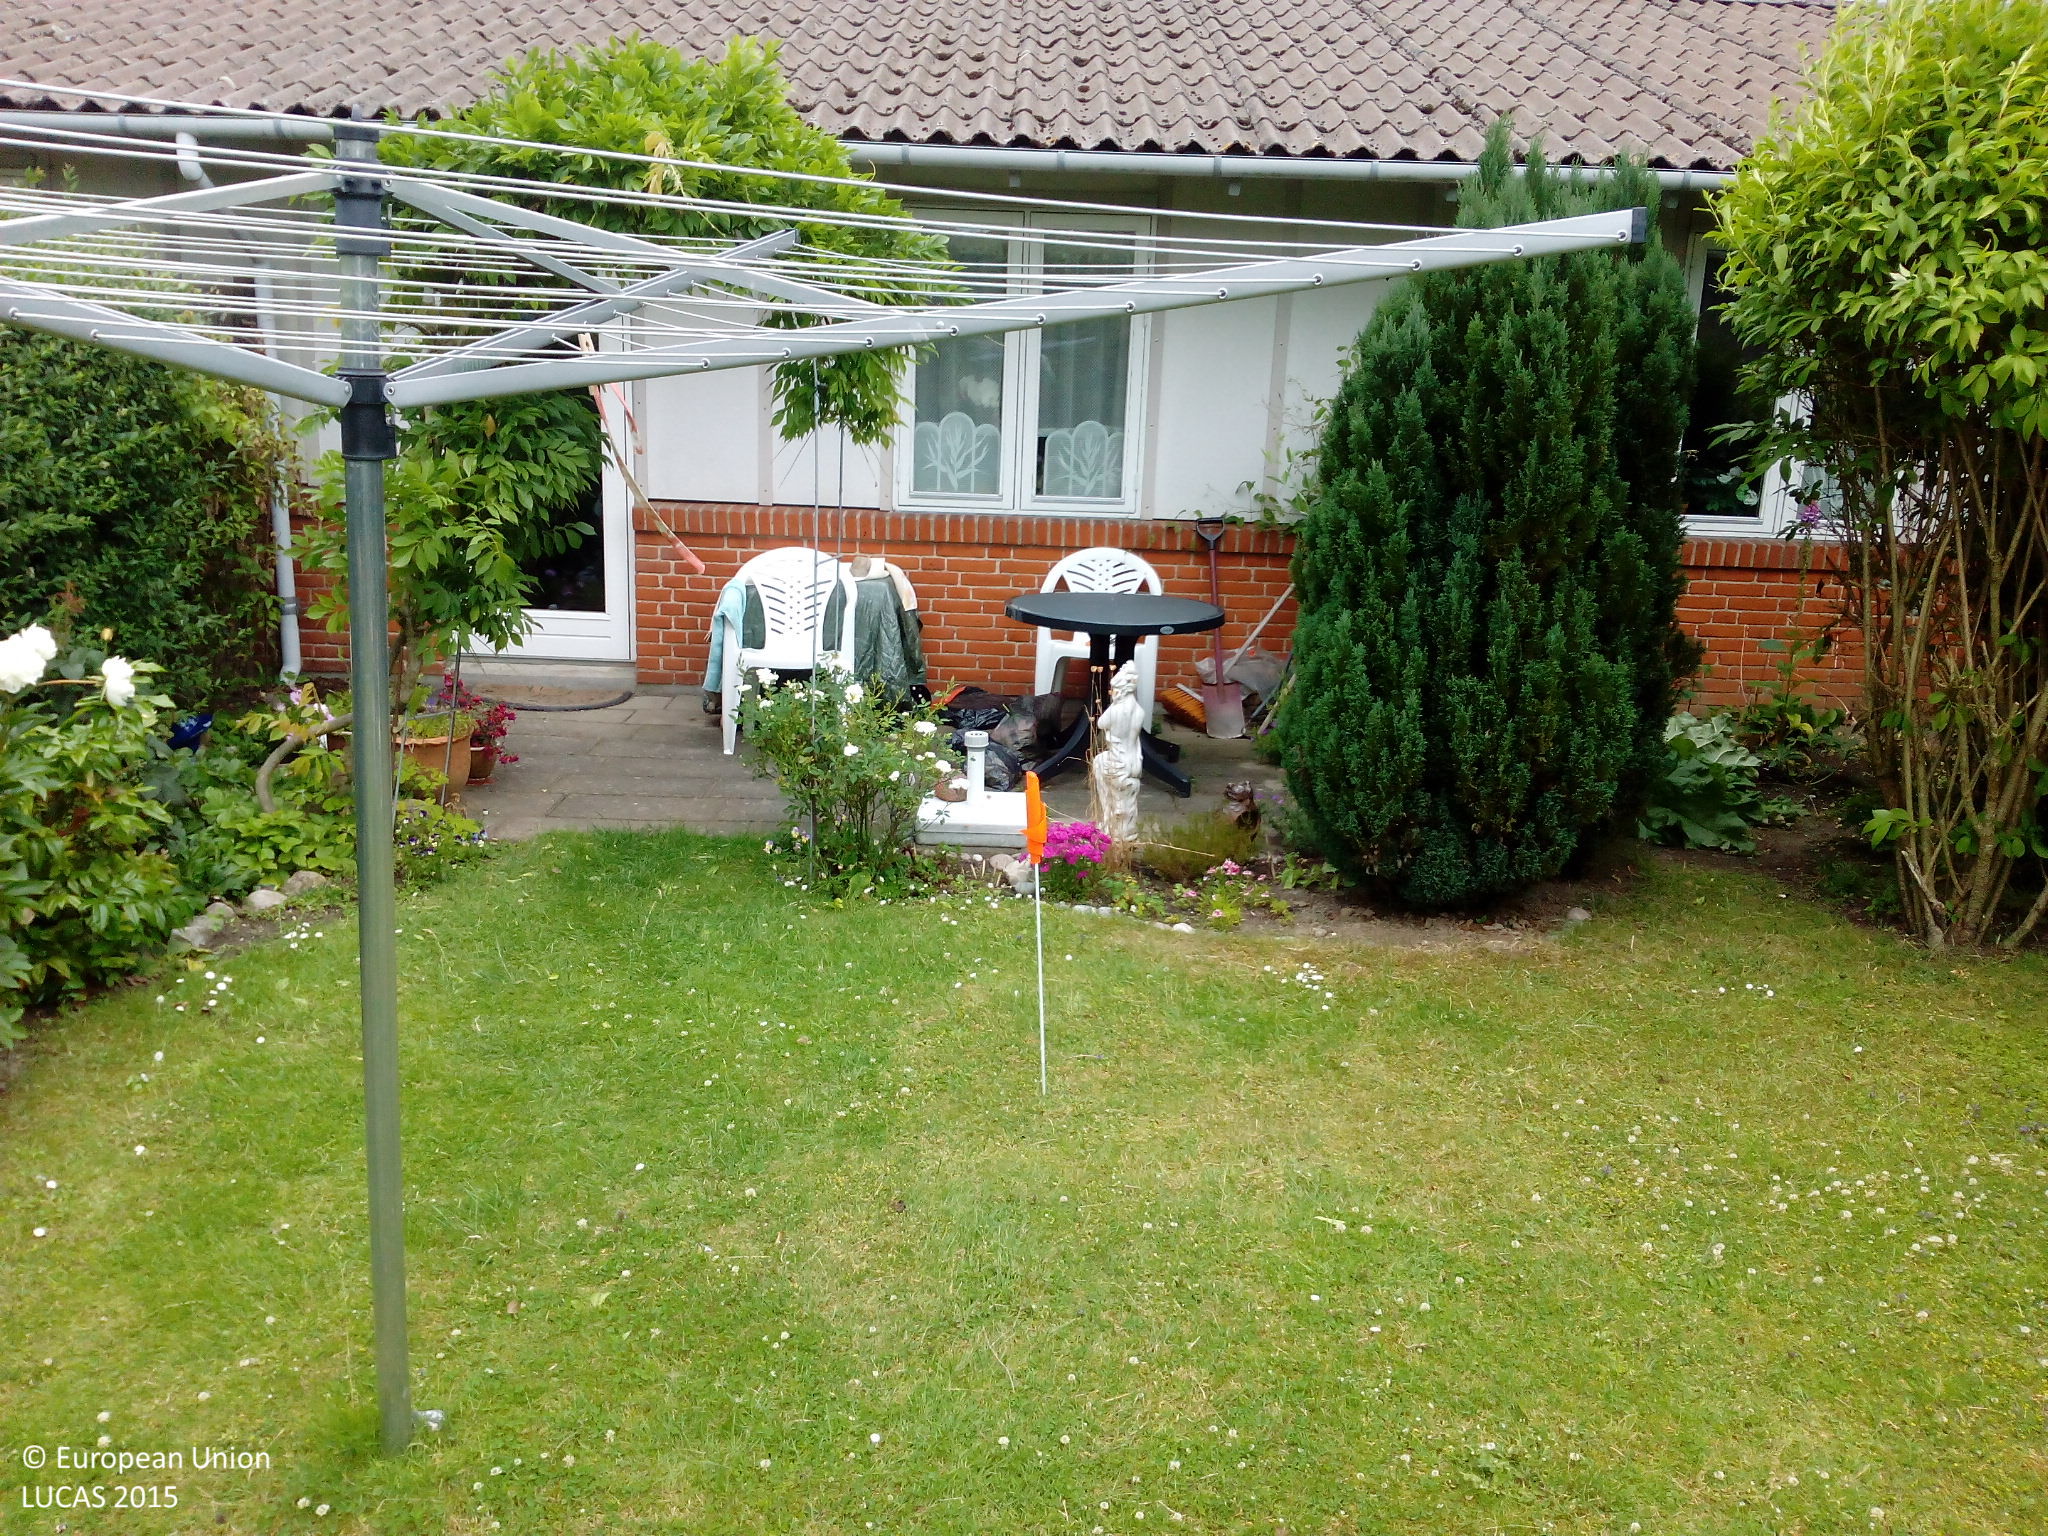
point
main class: Grassland
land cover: Grassland without tree/shrub cover
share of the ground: > 75 %
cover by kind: herbaceous plants 100 %
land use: Residential
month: July
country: DK
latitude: 55.2547
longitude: 12.0281
